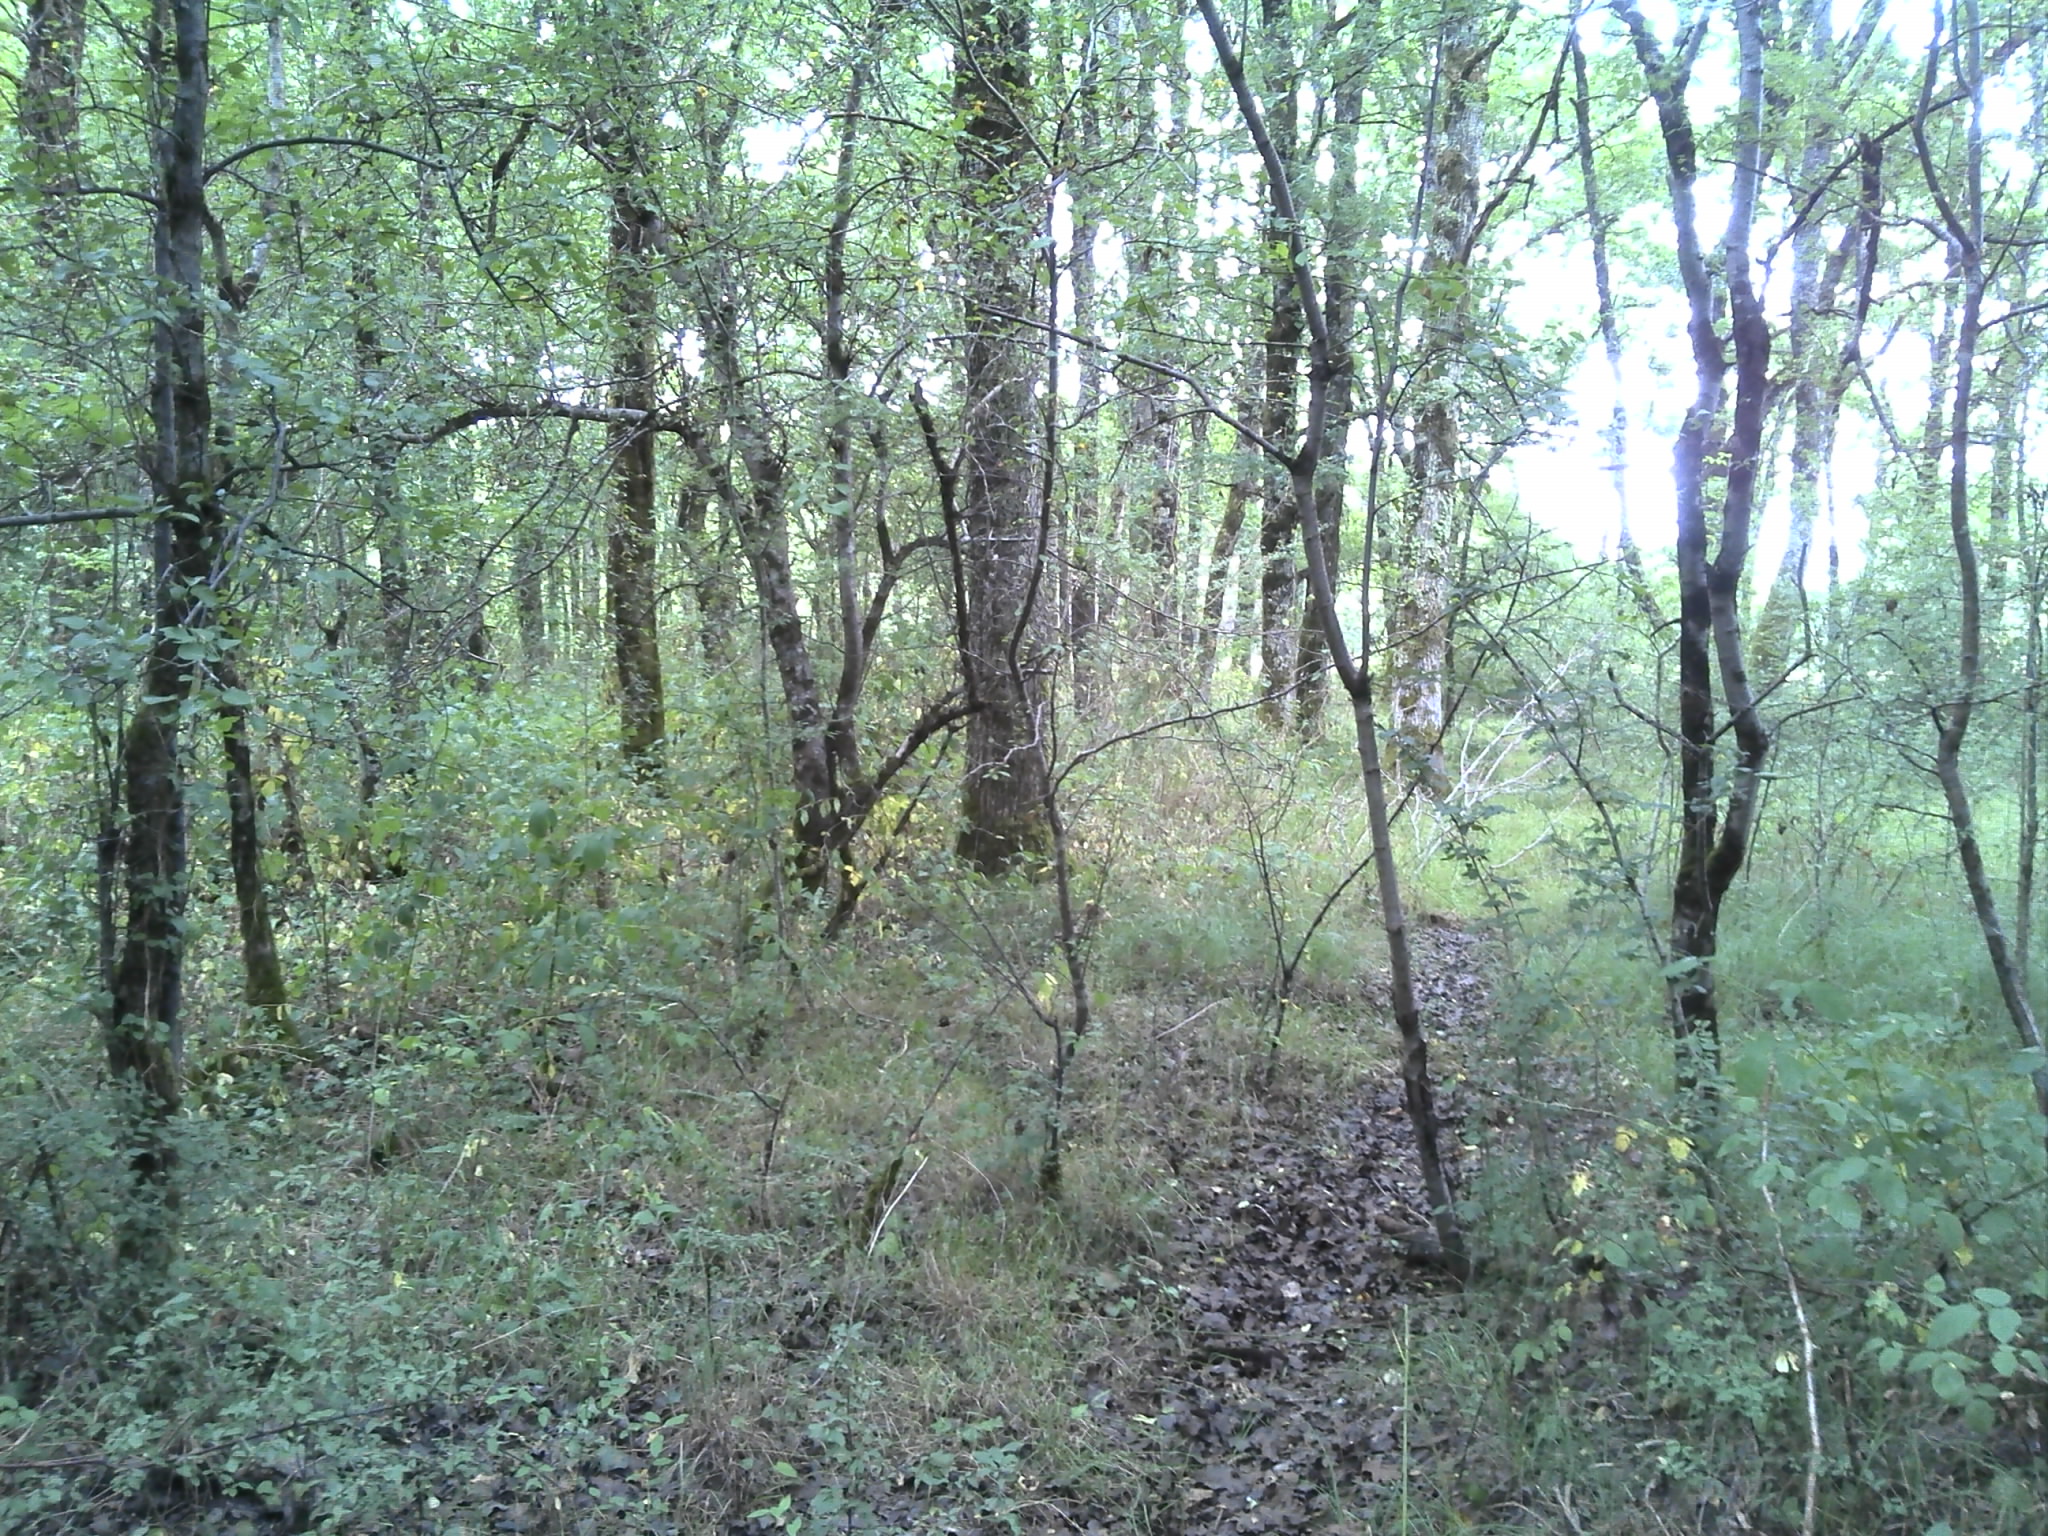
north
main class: Woodland
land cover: Broadleaved woodland
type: mesophytic deciduous forest
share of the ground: > 75 %
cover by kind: broadleaved forest trees 85 %, shrubs 10 %, herbaceous plants 5 %
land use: Forestry
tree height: > 5 m
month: July
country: FR
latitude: 46.7520
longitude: 1.4664
